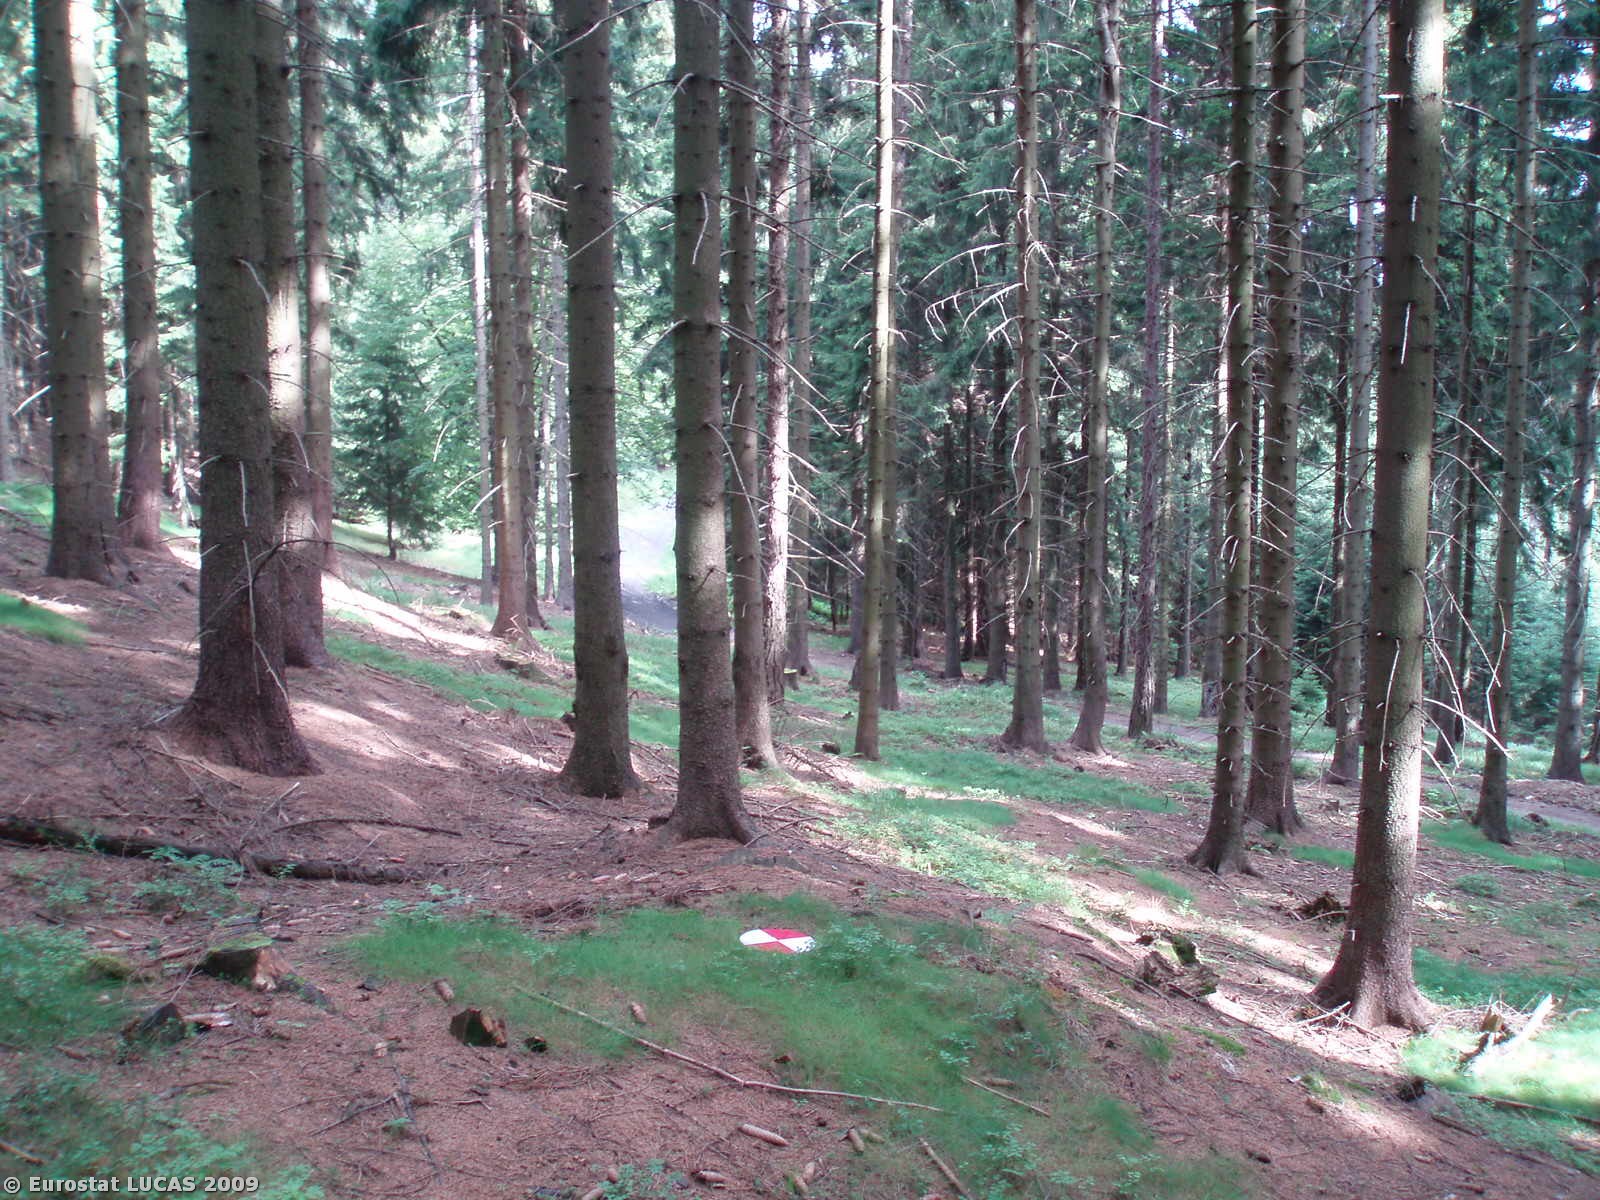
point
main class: Woodland
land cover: Coniferous woodland
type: hemiboreal forest and nemoral coniferous forest and mixed broadleaved-coniferous forest
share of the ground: > 75 %
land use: Forestry
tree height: > 5 m
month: July
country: CZ
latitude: 50.7601
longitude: 14.9788
